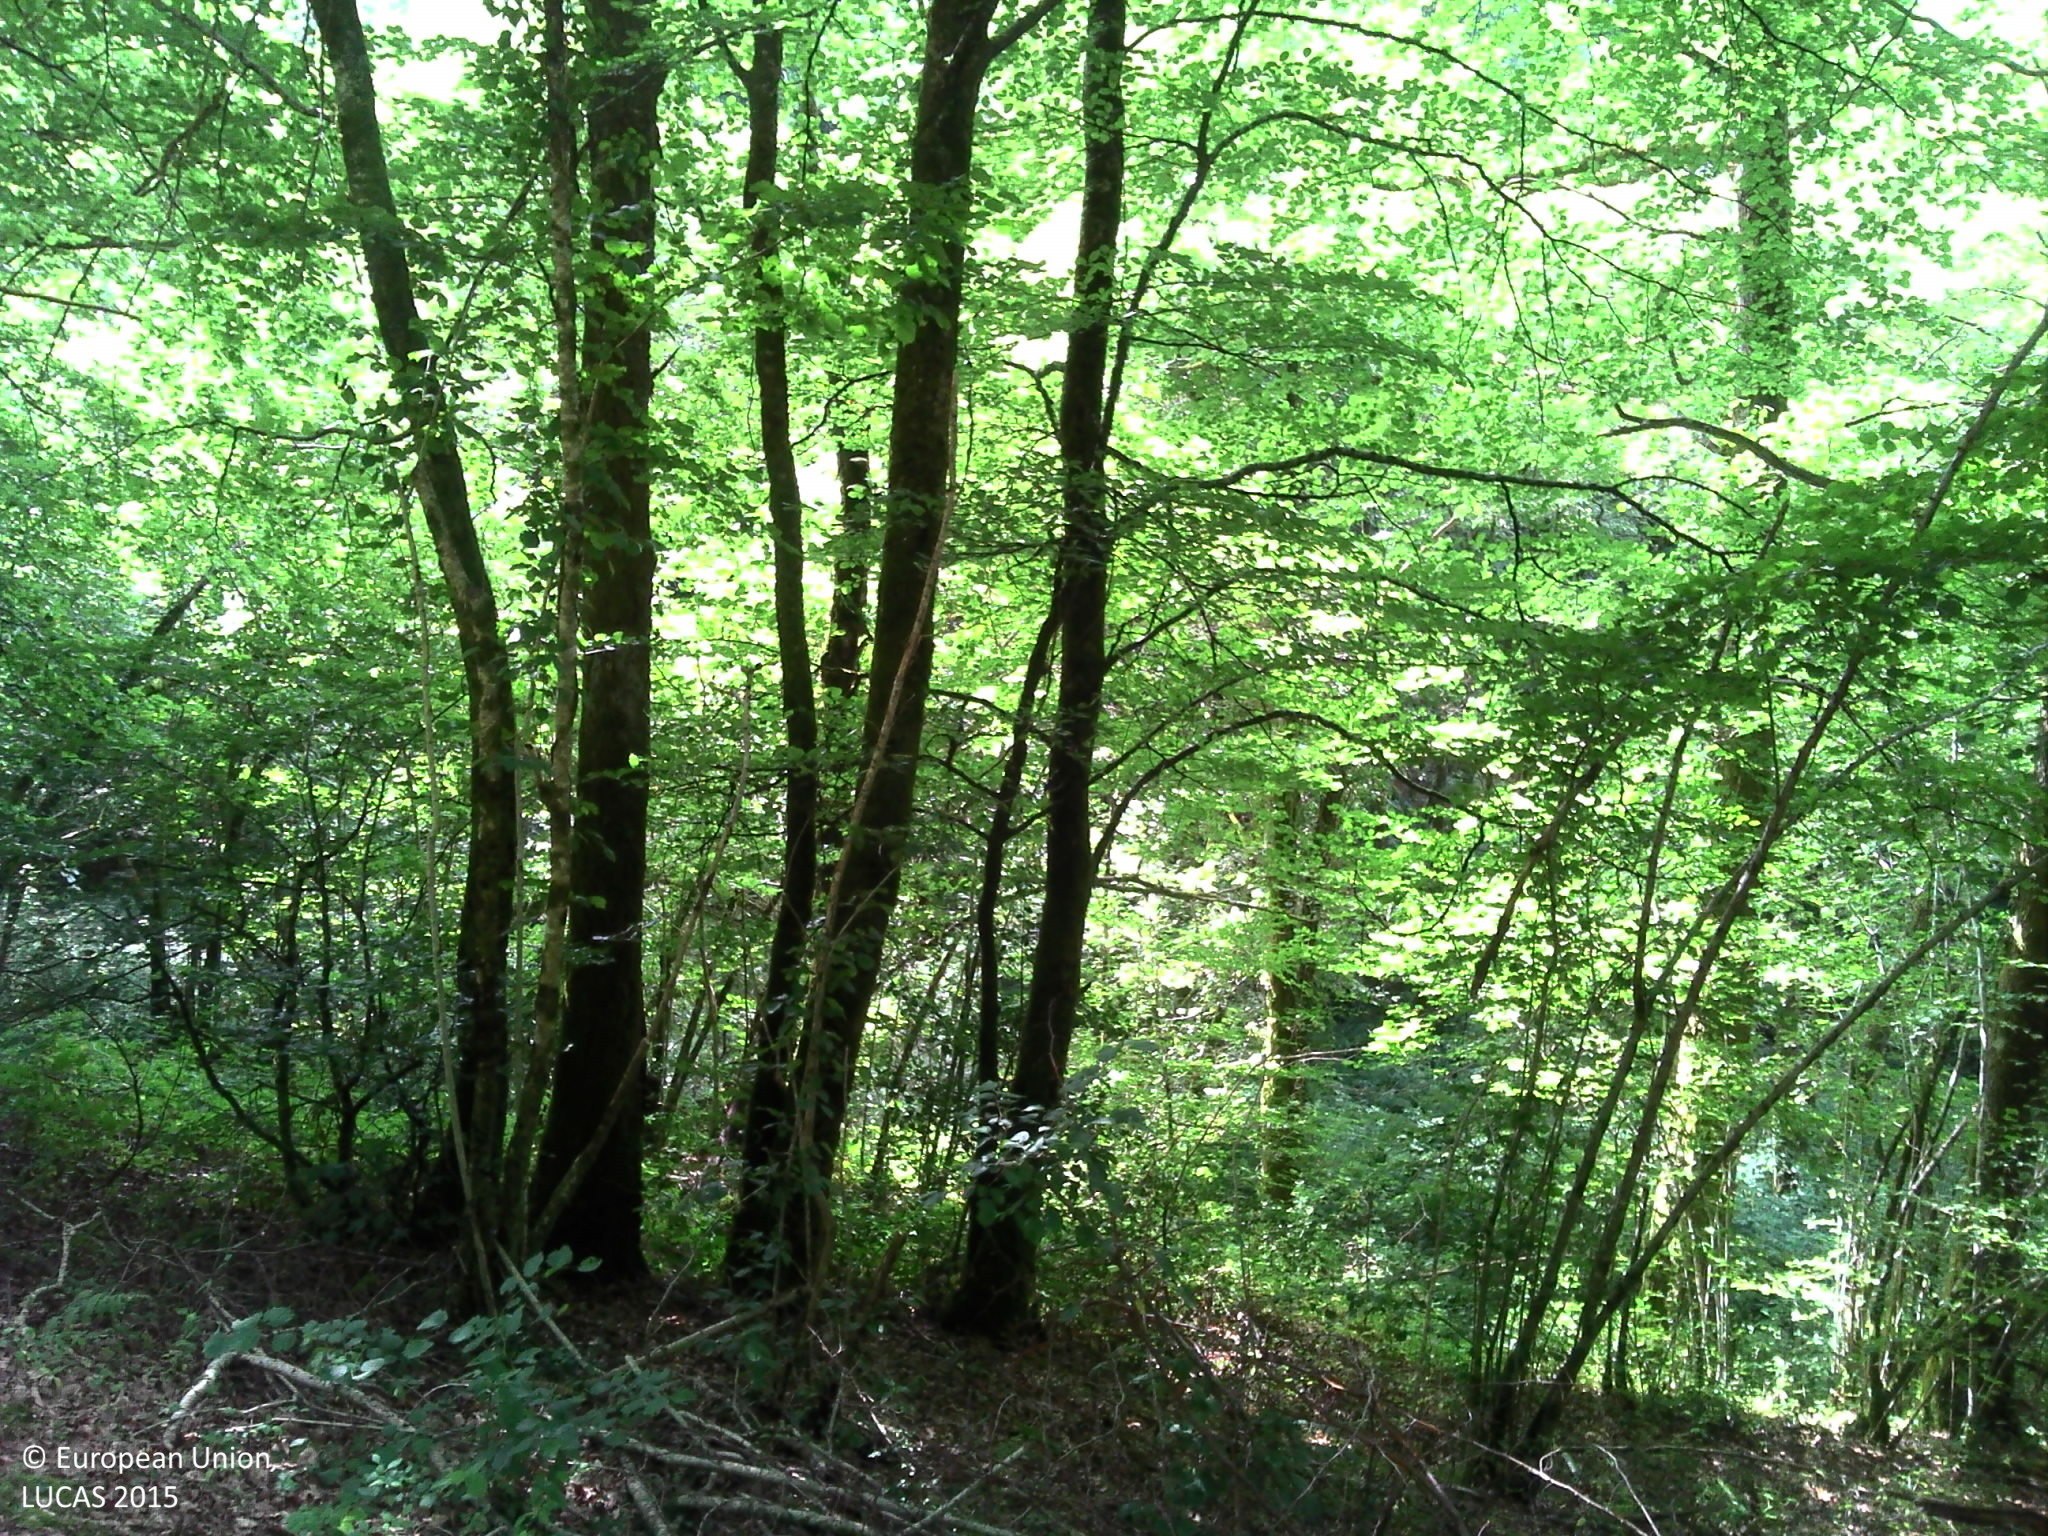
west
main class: Woodland
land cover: Broadleaved woodland
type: beech forest
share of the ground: > 75 %
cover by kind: broadleaved forest trees 70 %, herbaceous plants 25 %, lichens and mosses 5 %
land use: Forestry
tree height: > 5 m
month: July
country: FR
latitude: 45.6593
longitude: 1.8453
